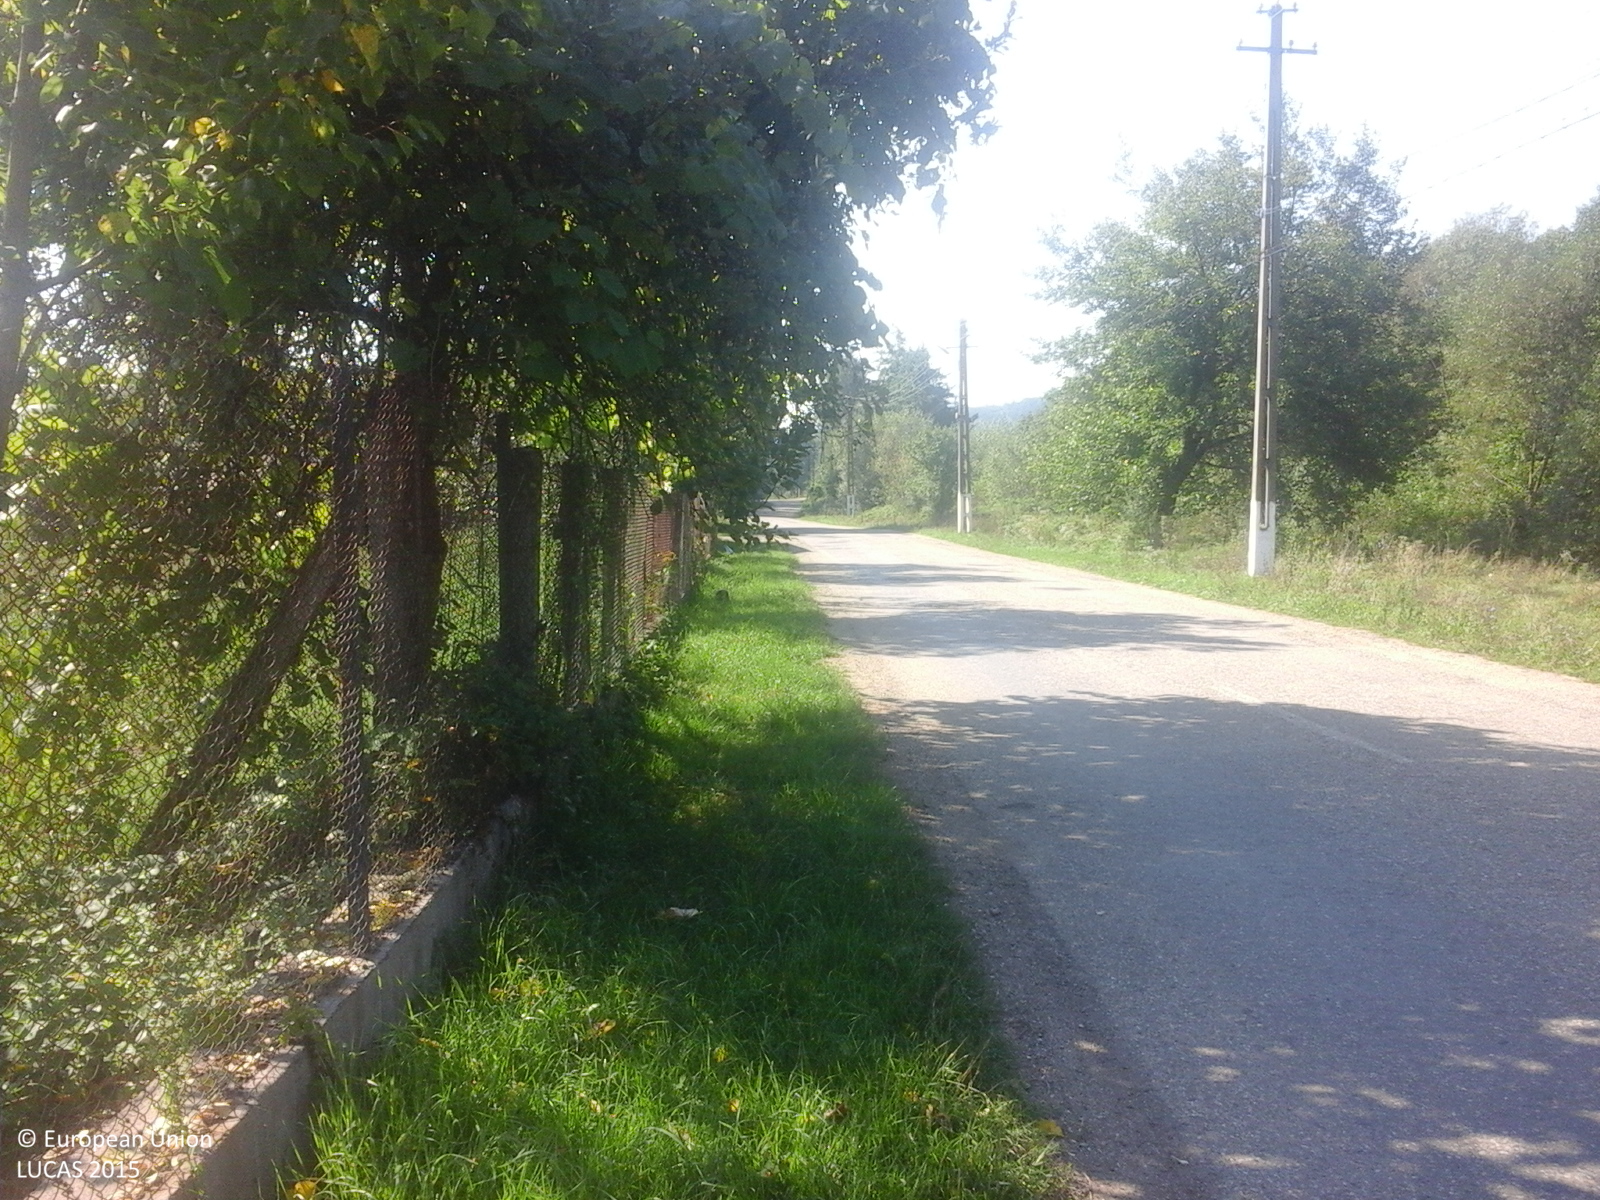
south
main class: Grassland
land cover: Grassland without tree/shrub cover
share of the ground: > 75 %
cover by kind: herbaceous plants 100 %
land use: Agriculture (excluding fallow land and kitchen gardens)
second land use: Residential
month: August
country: RO
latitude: 46.0467
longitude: 22.3889
